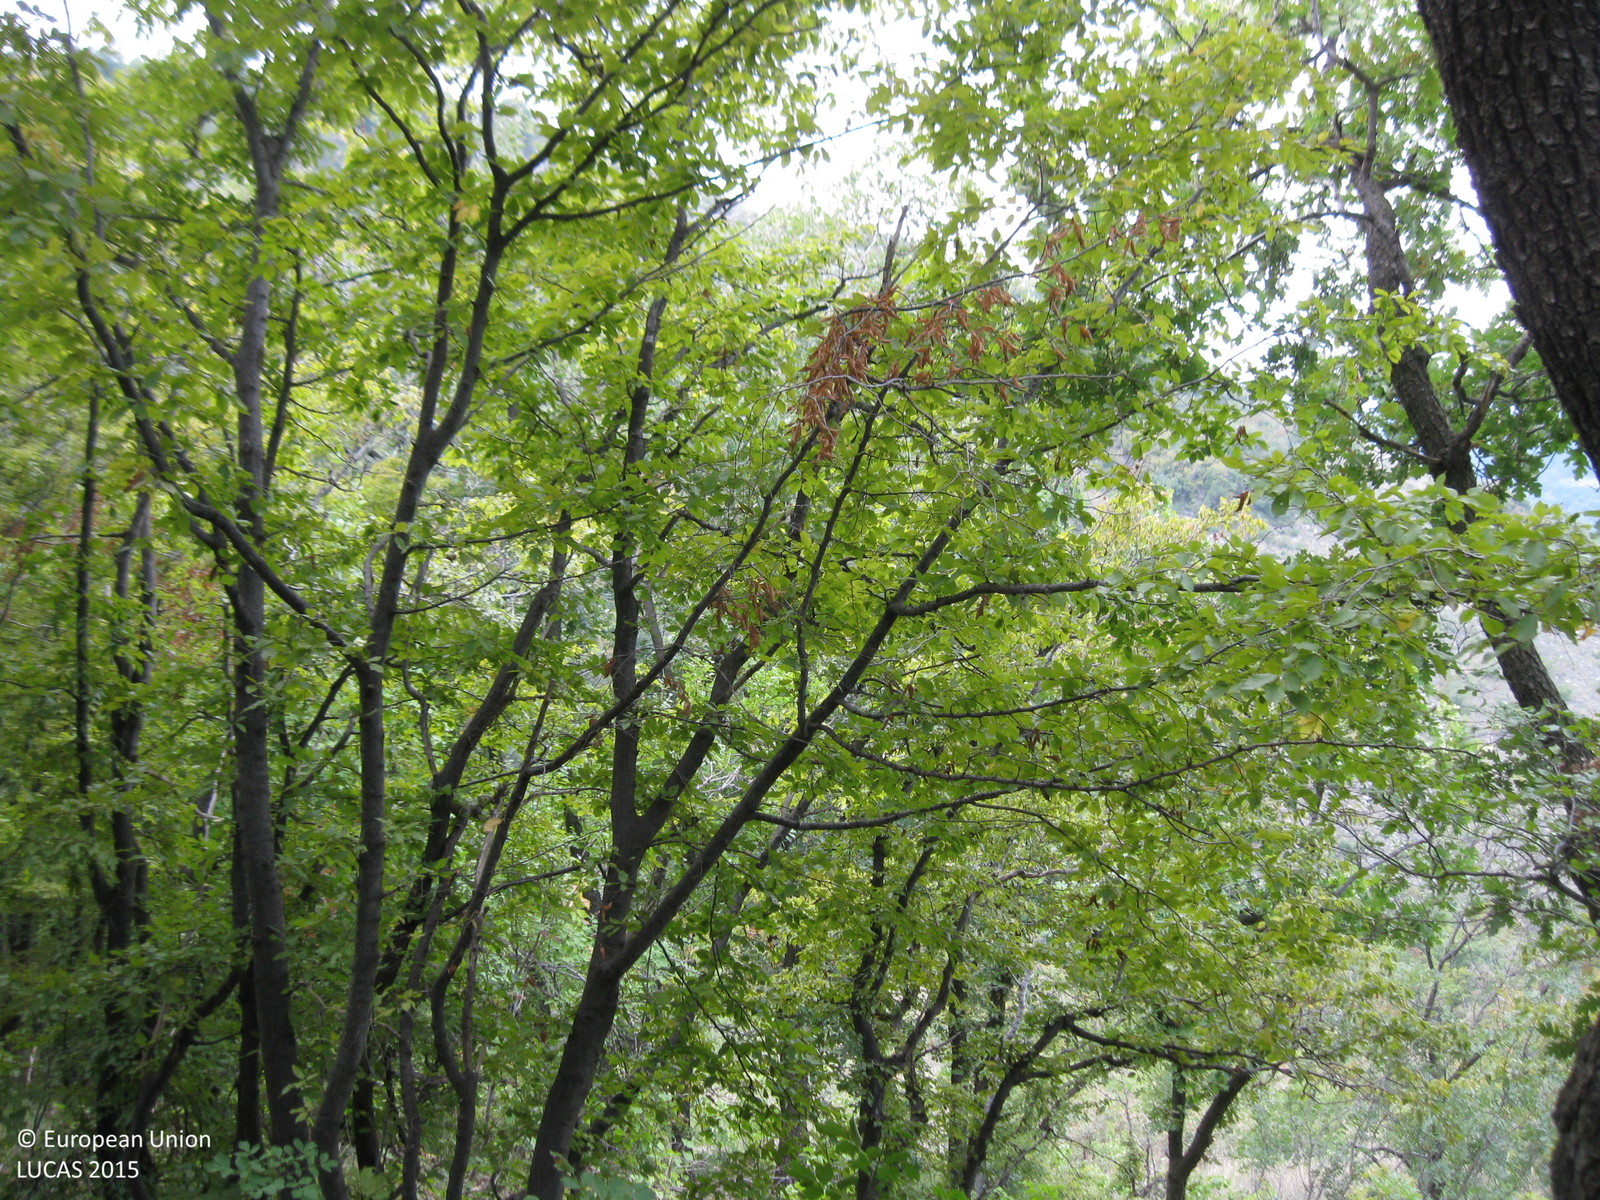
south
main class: Woodland
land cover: Broadleaved woodland
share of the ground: > 75 %
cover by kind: broadleaved forest trees 100 %
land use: Forestry
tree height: < 5 m
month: October
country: BG
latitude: 42.0505
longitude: 24.7054
